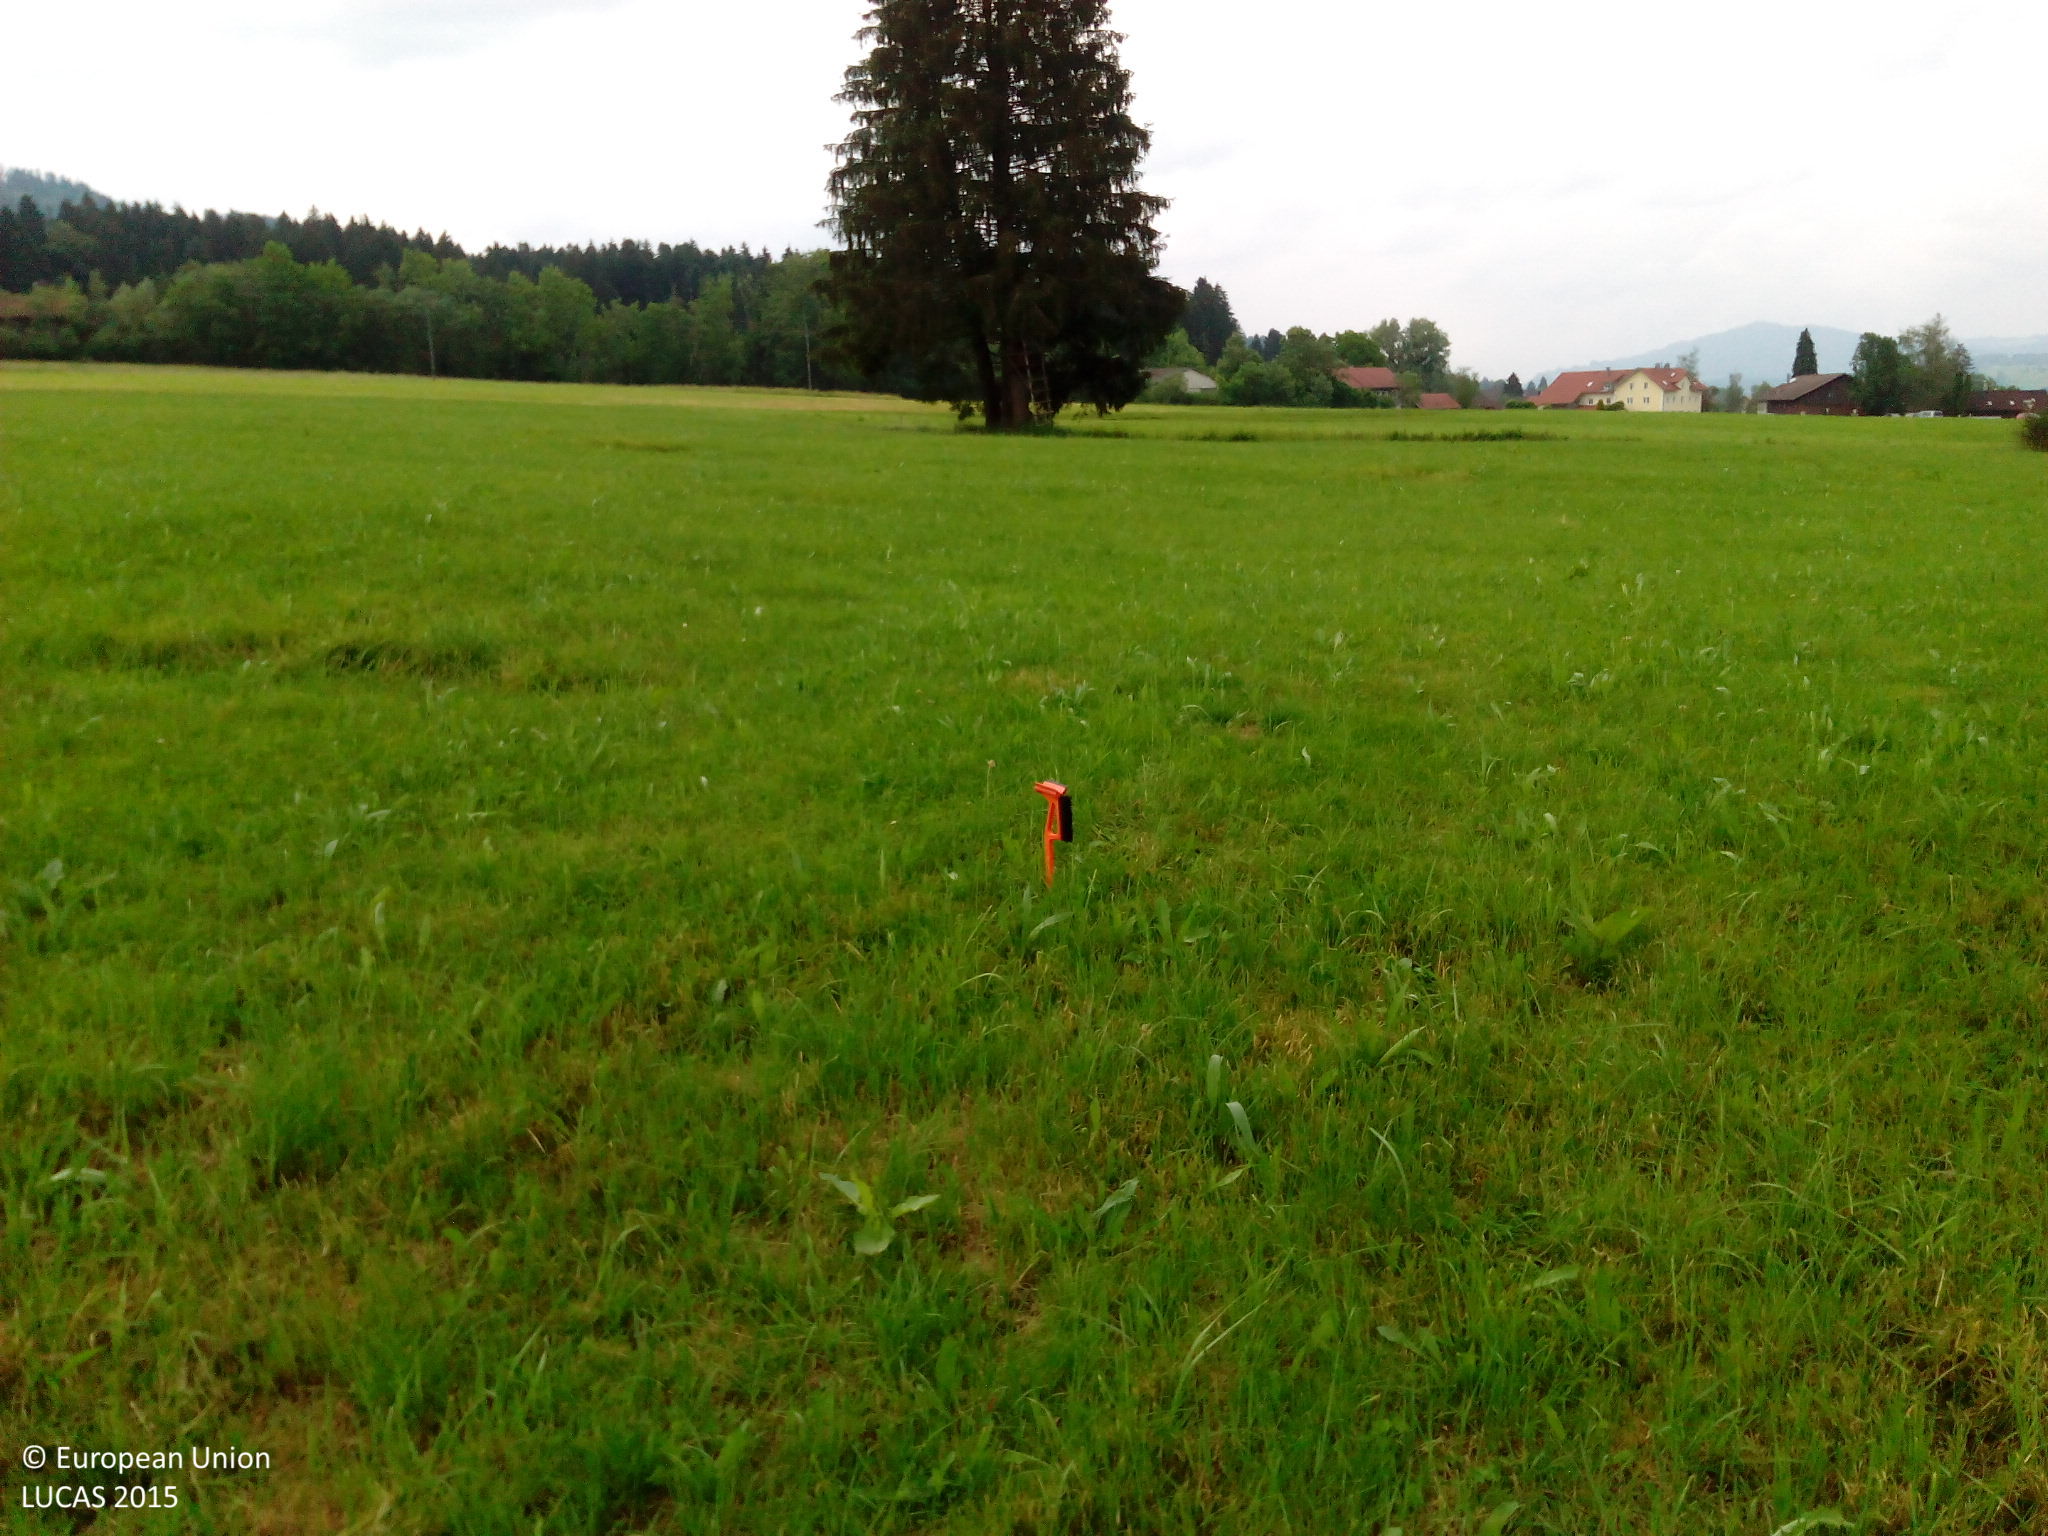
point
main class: Grassland
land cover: Grassland without tree/shrub cover
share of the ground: > 75 %
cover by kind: herbaceous plants 100 %
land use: Agriculture (excluding fallow land and kitchen gardens)
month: June
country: DE
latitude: 47.5936
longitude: 9.9336
